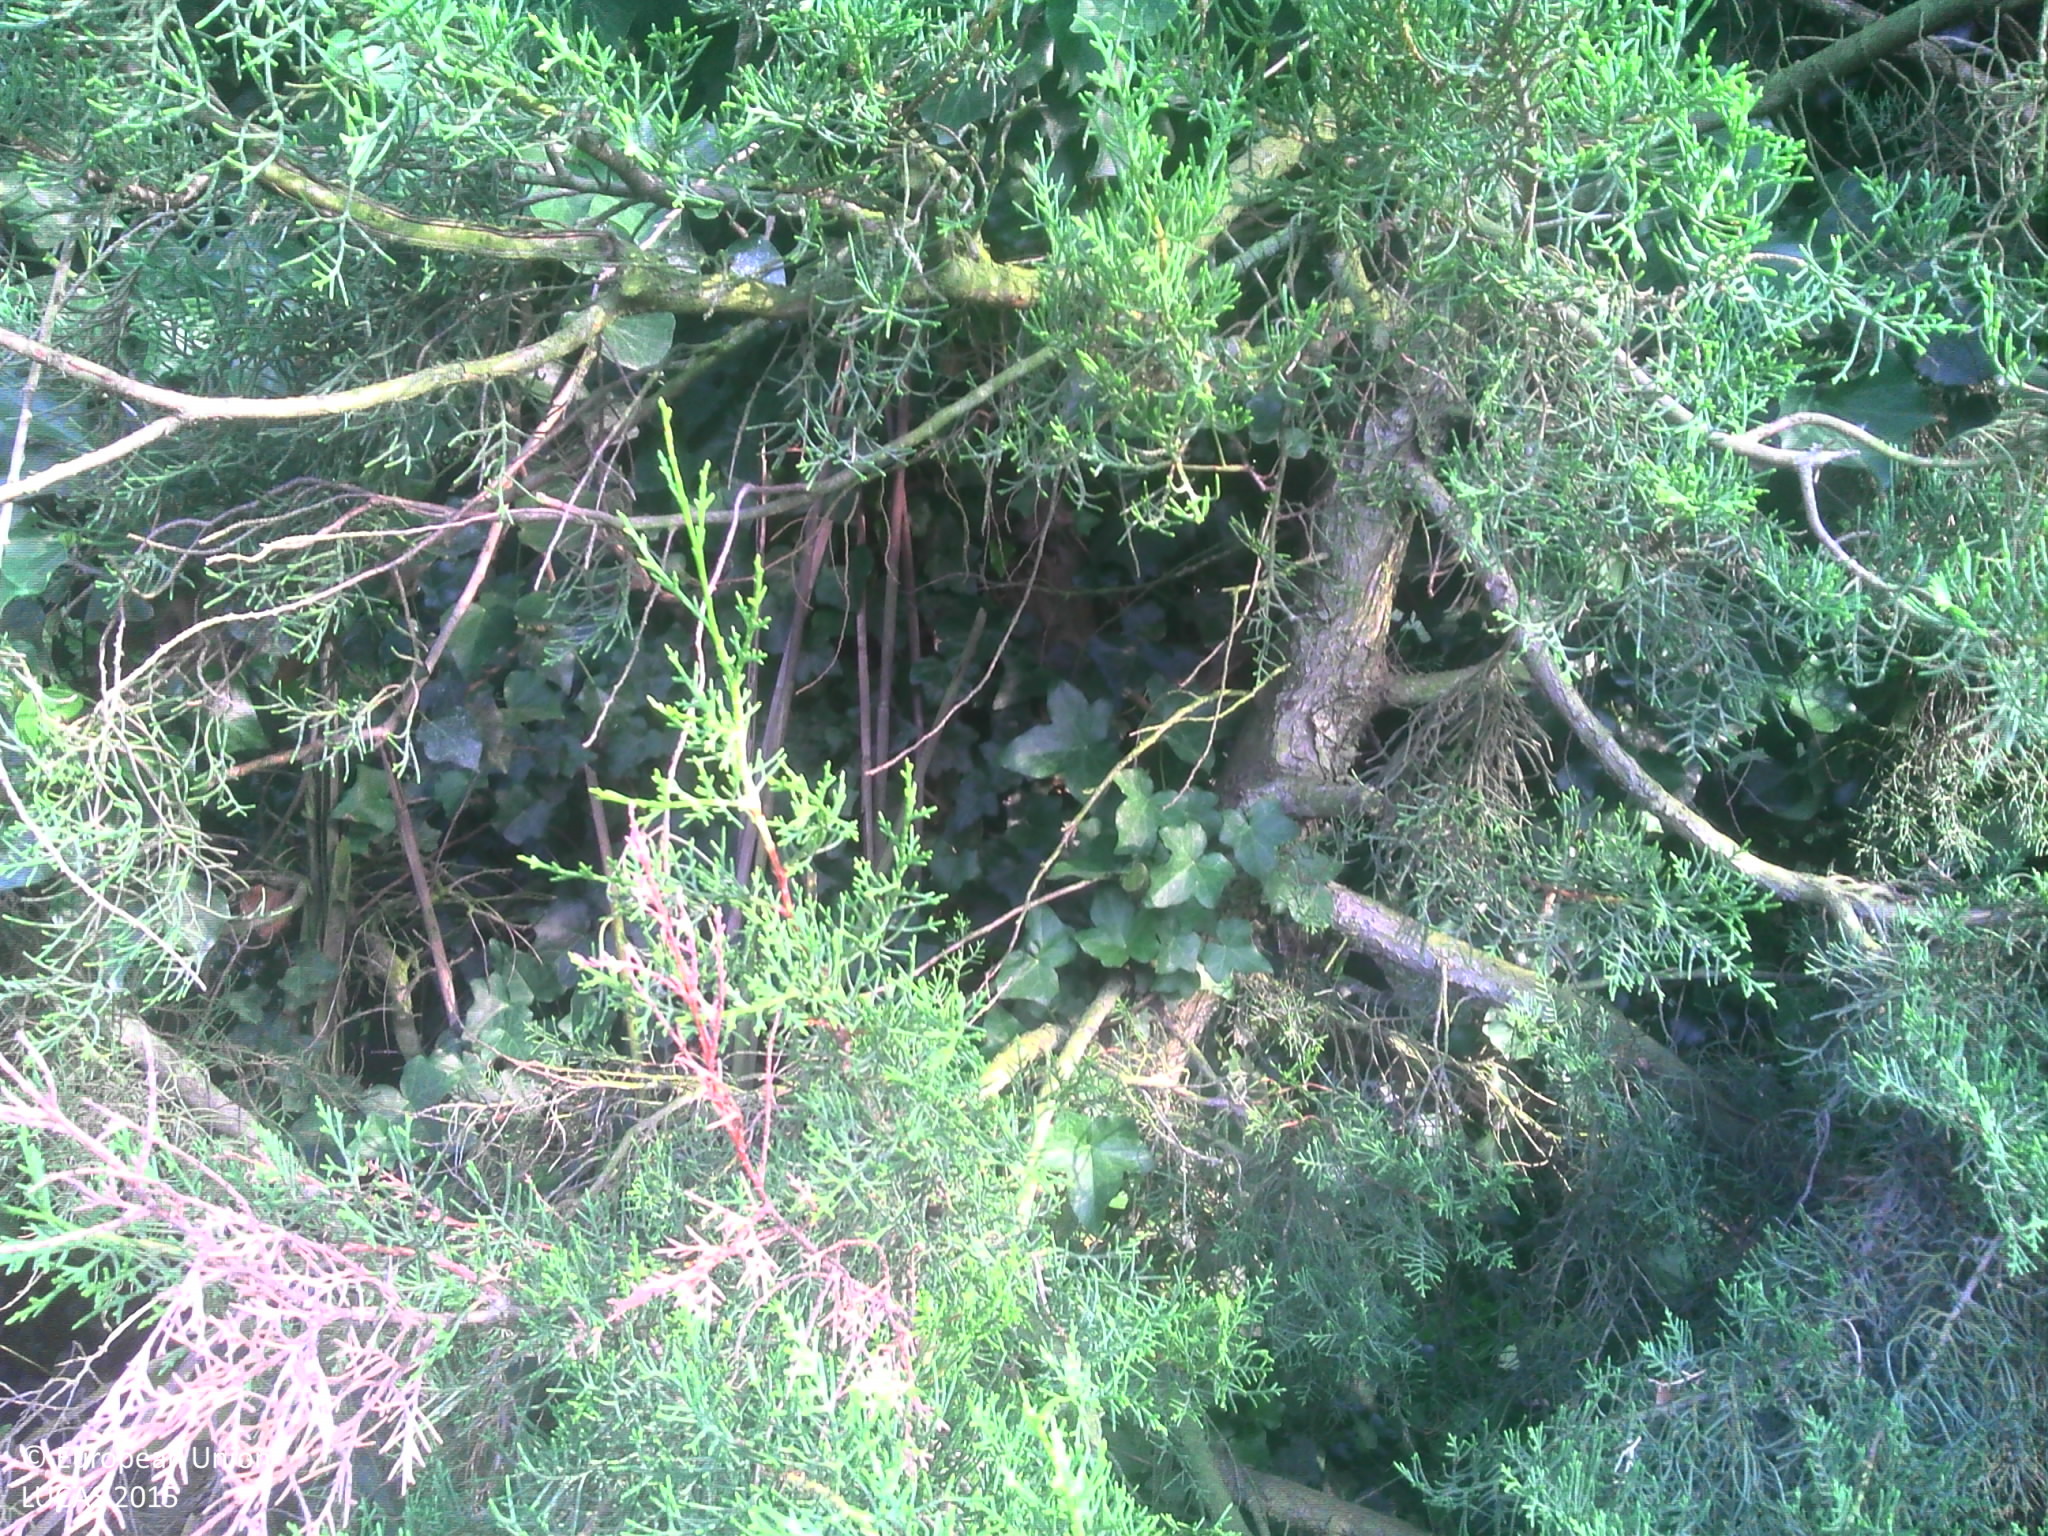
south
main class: Cropland
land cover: Pear fruit
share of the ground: > 75 %
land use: Agriculture (excluding fallow land and kitchen gardens)
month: July
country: FR
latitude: 43.7640
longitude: 5.0777
